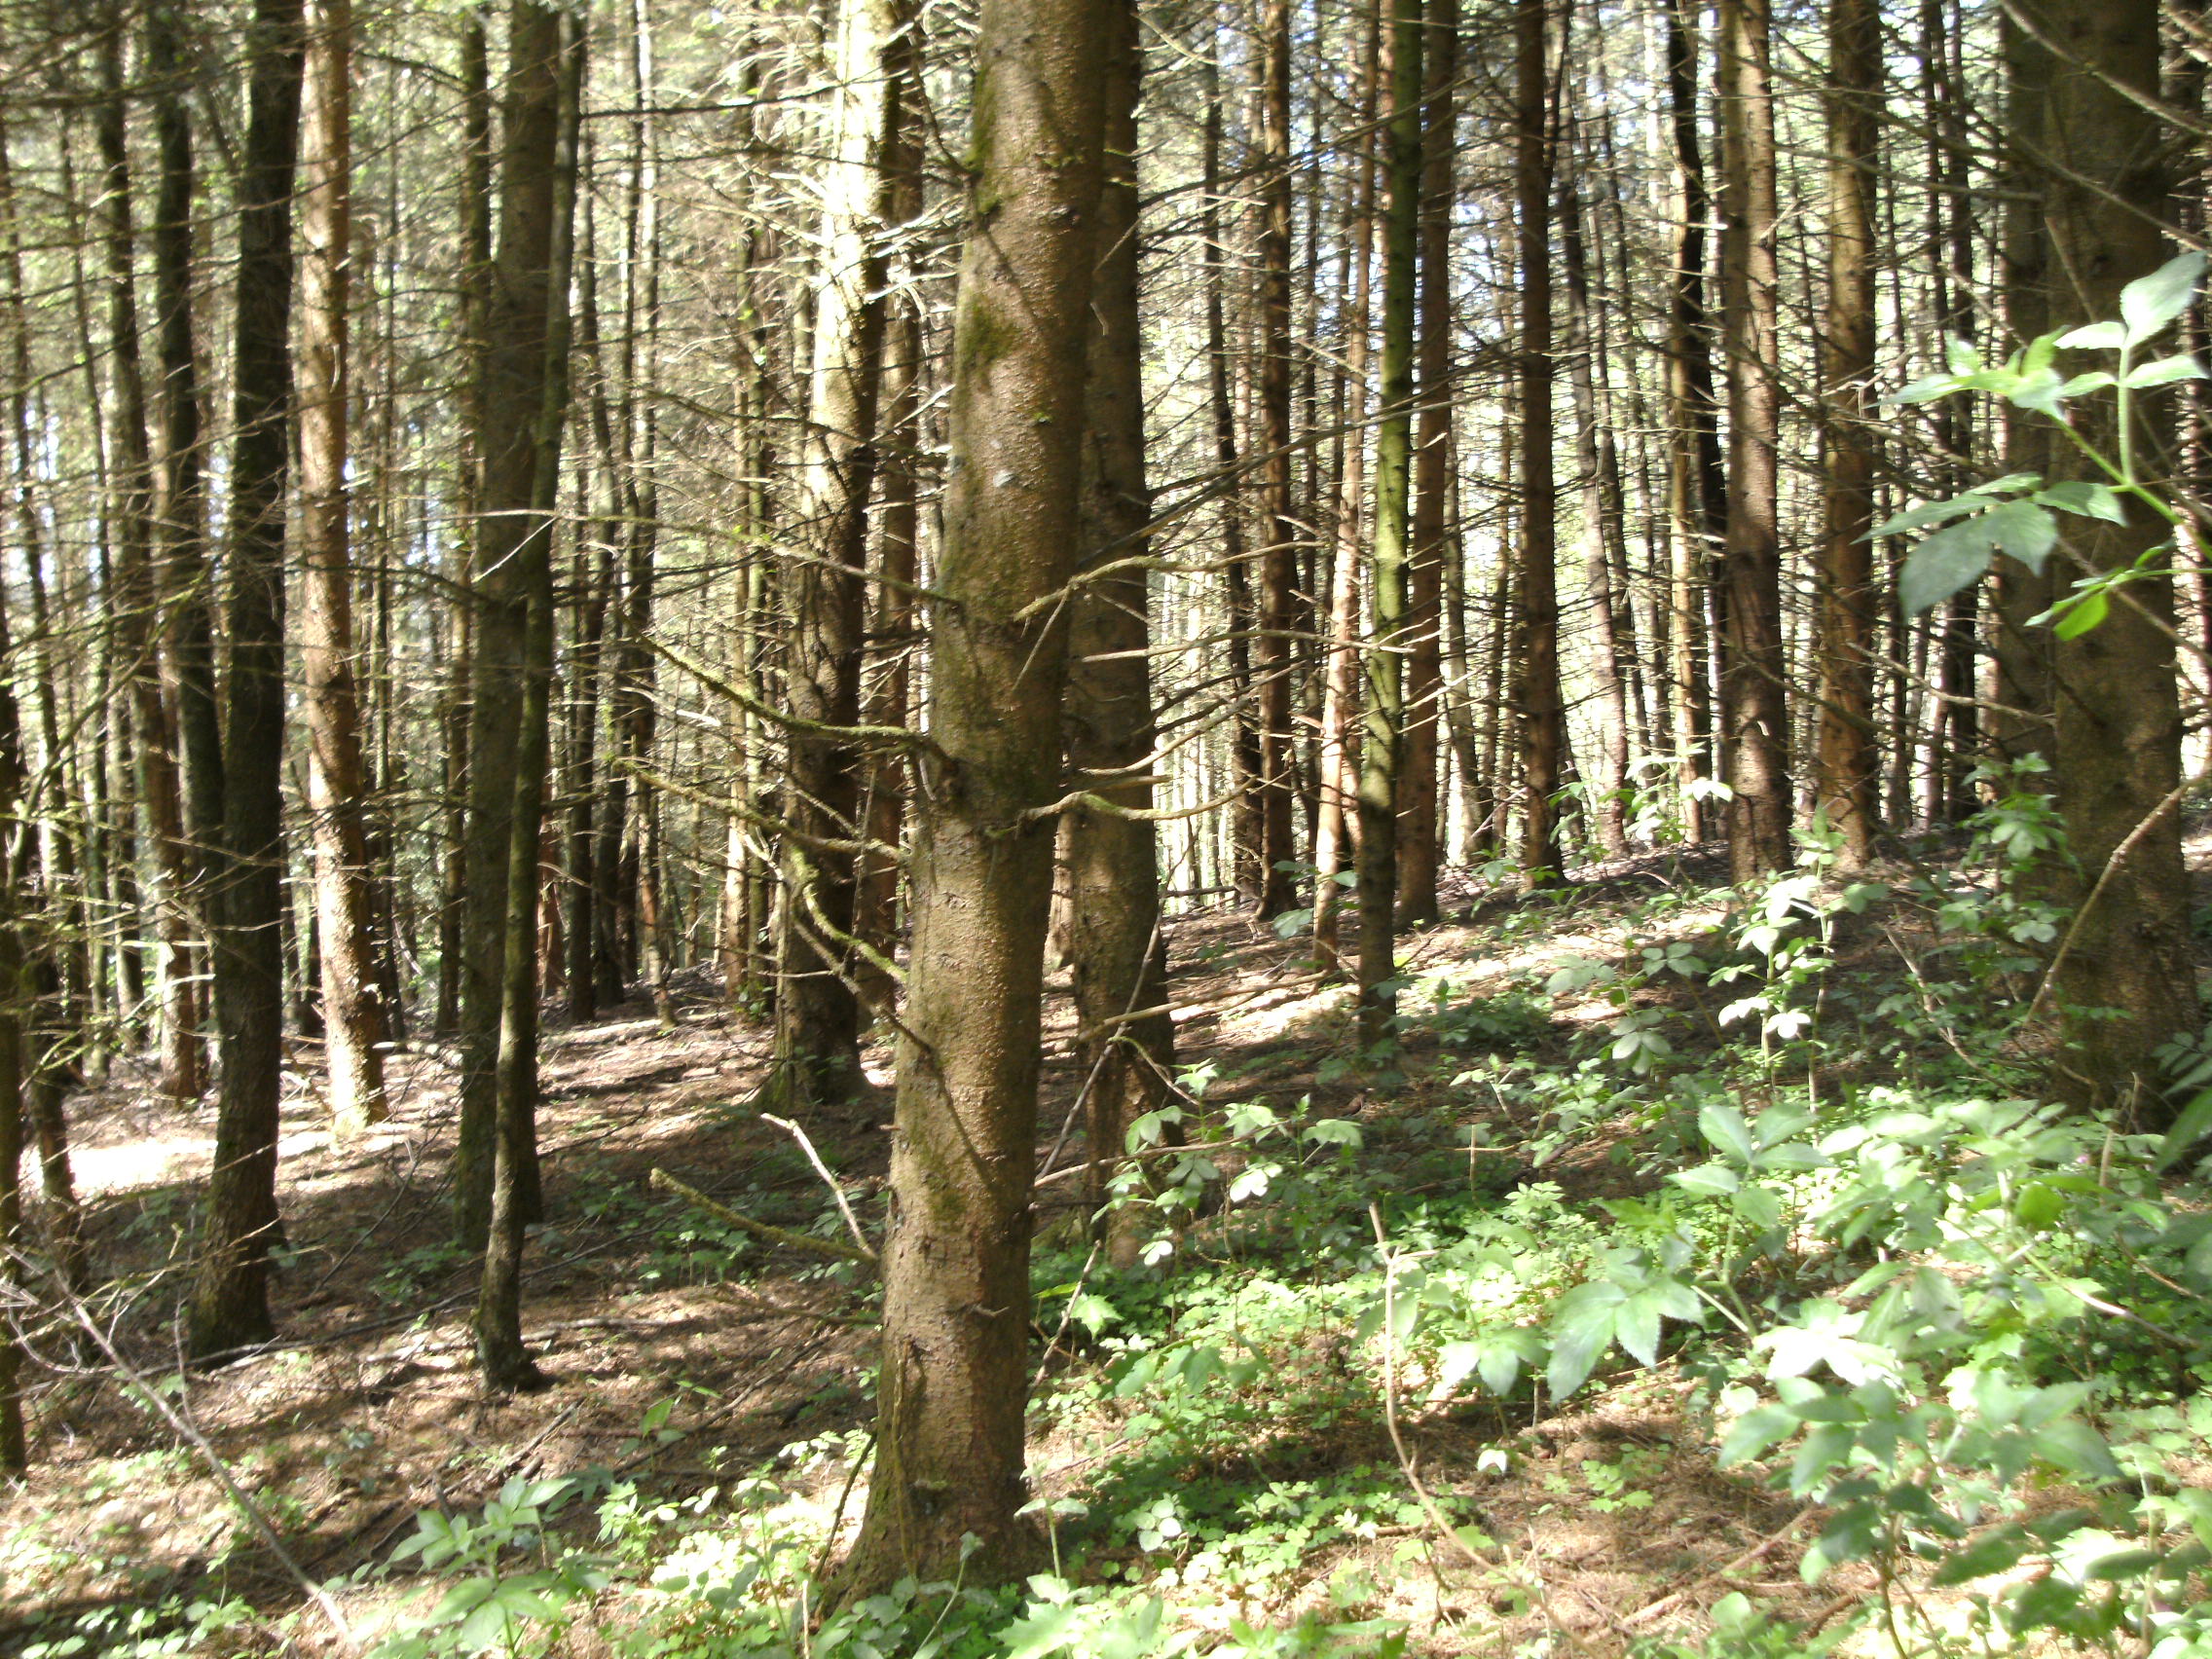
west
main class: Woodland
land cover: Spruce dominated coniferous woodland
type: hemiboreal forest and nemoral coniferous forest and mixed broadleaved-coniferous forest
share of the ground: > 75 %
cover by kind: coniferous forest trees 90 %, broadleaved forest trees 5 %, herbaceous plants 5 %
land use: Forestry
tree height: > 5 m
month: May
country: AT
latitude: 48.5263
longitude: 13.5608
